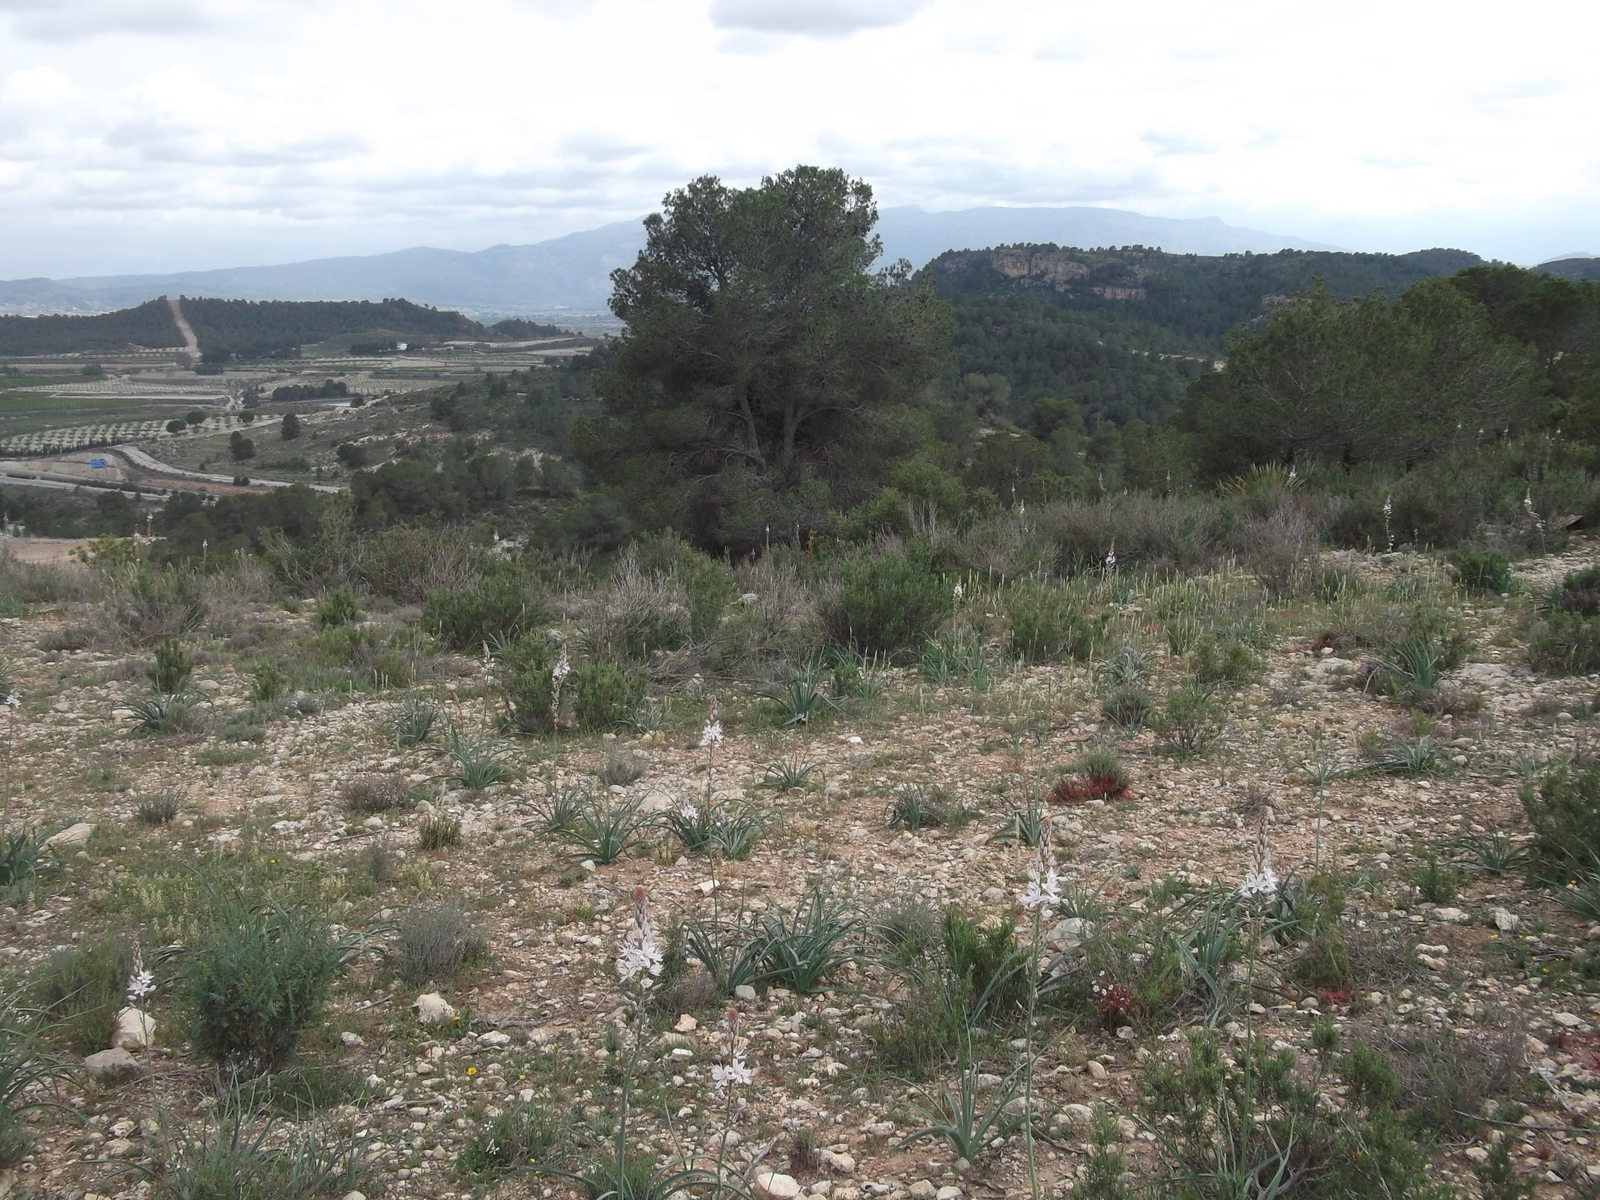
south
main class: Shrubland
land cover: Shrubland without tree cover
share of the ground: 10 - 25 %
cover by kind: herbaceous plants 75 %, shrubs 25 %
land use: Abandoned areas
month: April
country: ES
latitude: 38.0652
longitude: -1.5560
